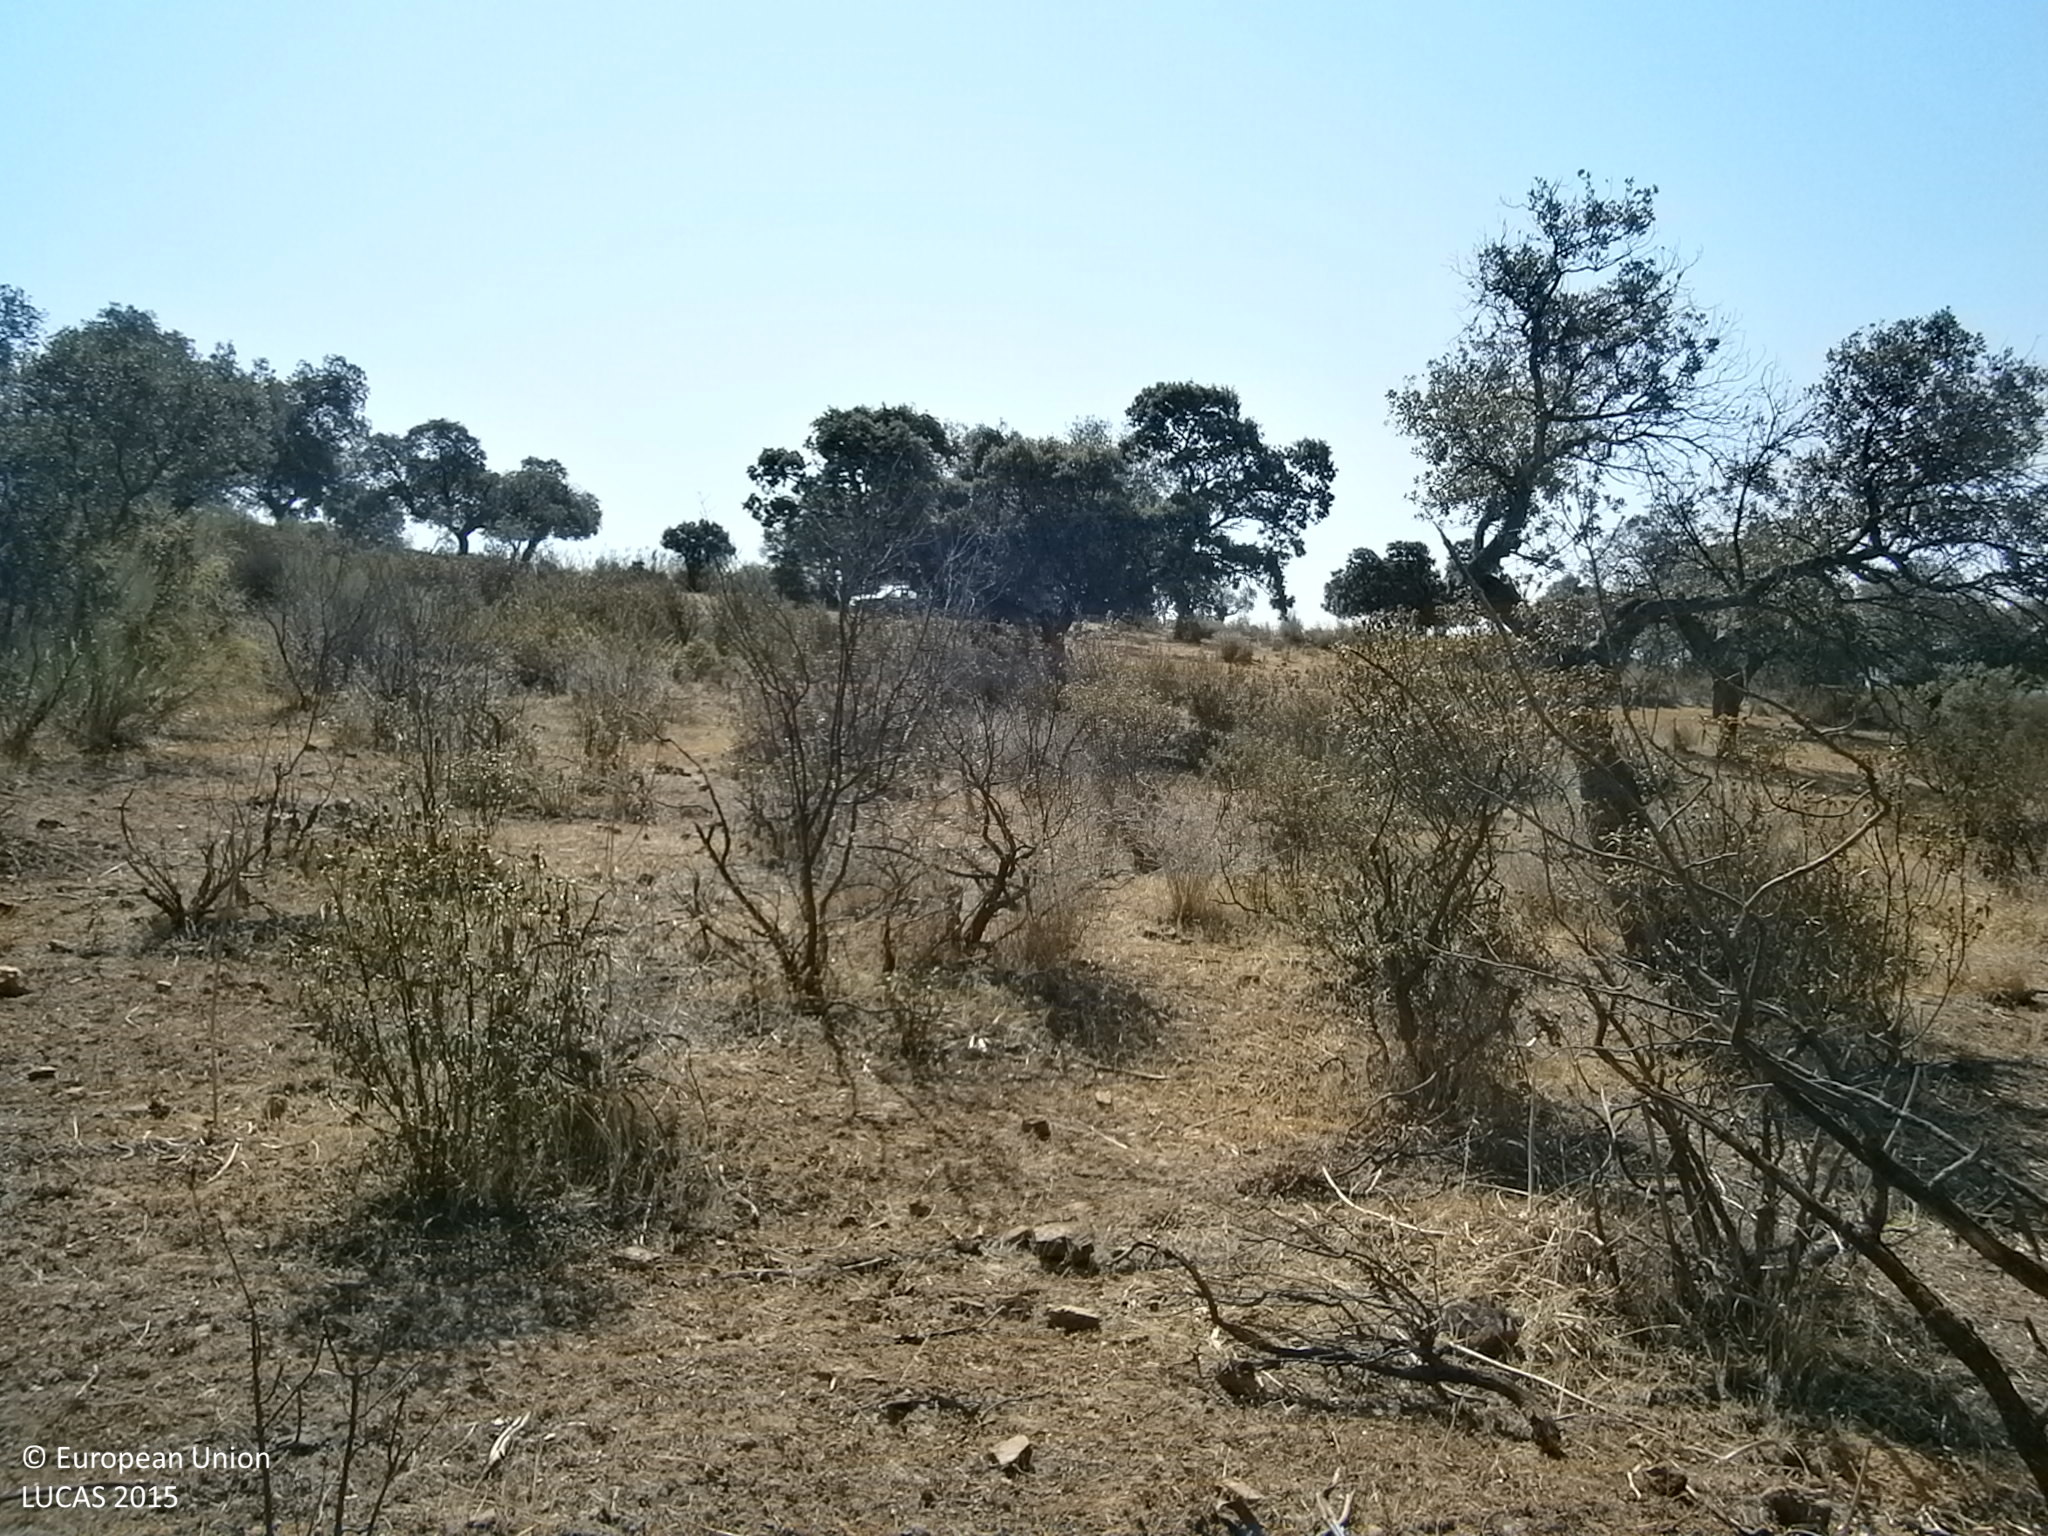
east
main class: Shrubland
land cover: Shrubland without tree cover
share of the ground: 10 - 25 %
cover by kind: herbaceous plants 40 %, unconsolidated bare surface 40 %, shrubs 20 %
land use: Semi-natural and natural areas not in use
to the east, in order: Shrubland without tree cover
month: June
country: ES
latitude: 38.5860
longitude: -6.6933
